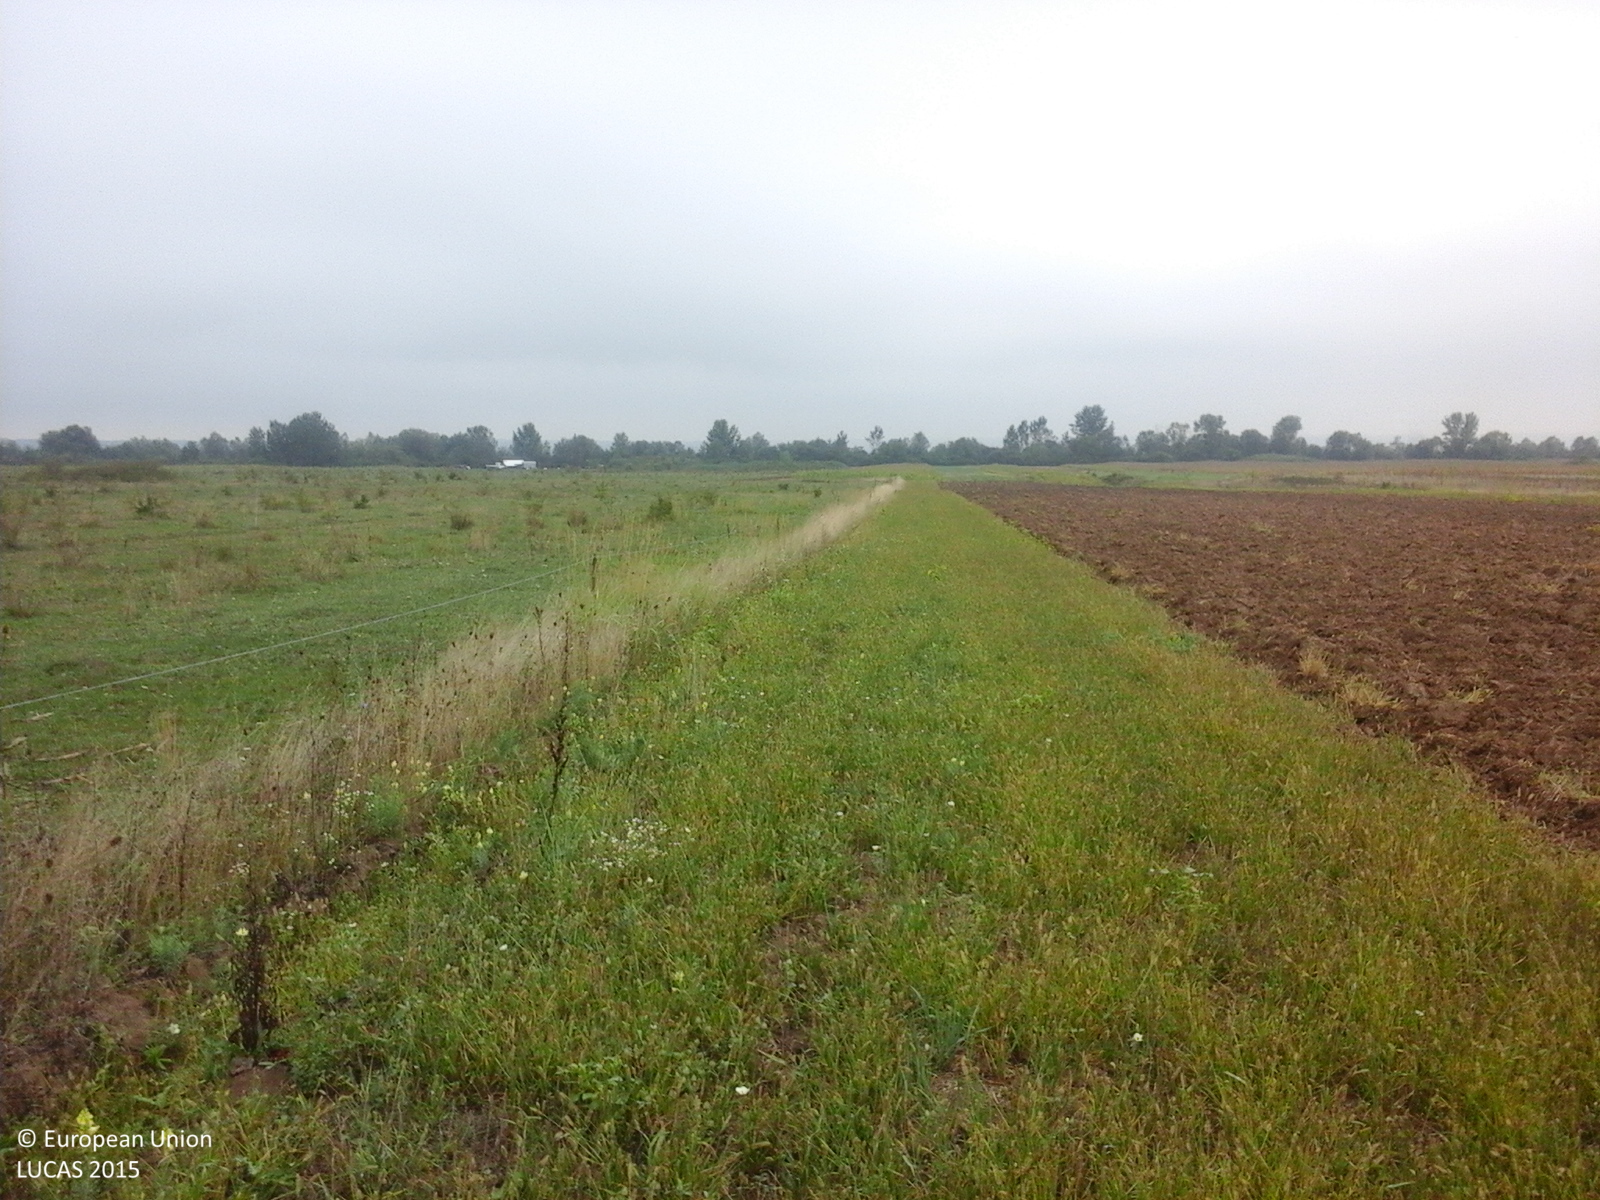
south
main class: Grassland
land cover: Grassland with sparse tree/shrub cover
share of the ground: > 75 %
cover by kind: herbaceous plants 95 %, broadleaved forest trees 5 %
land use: Agriculture (excluding fallow land and kitchen gardens)
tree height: < 5 m
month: September
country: RO
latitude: 45.0360
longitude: 23.3454
